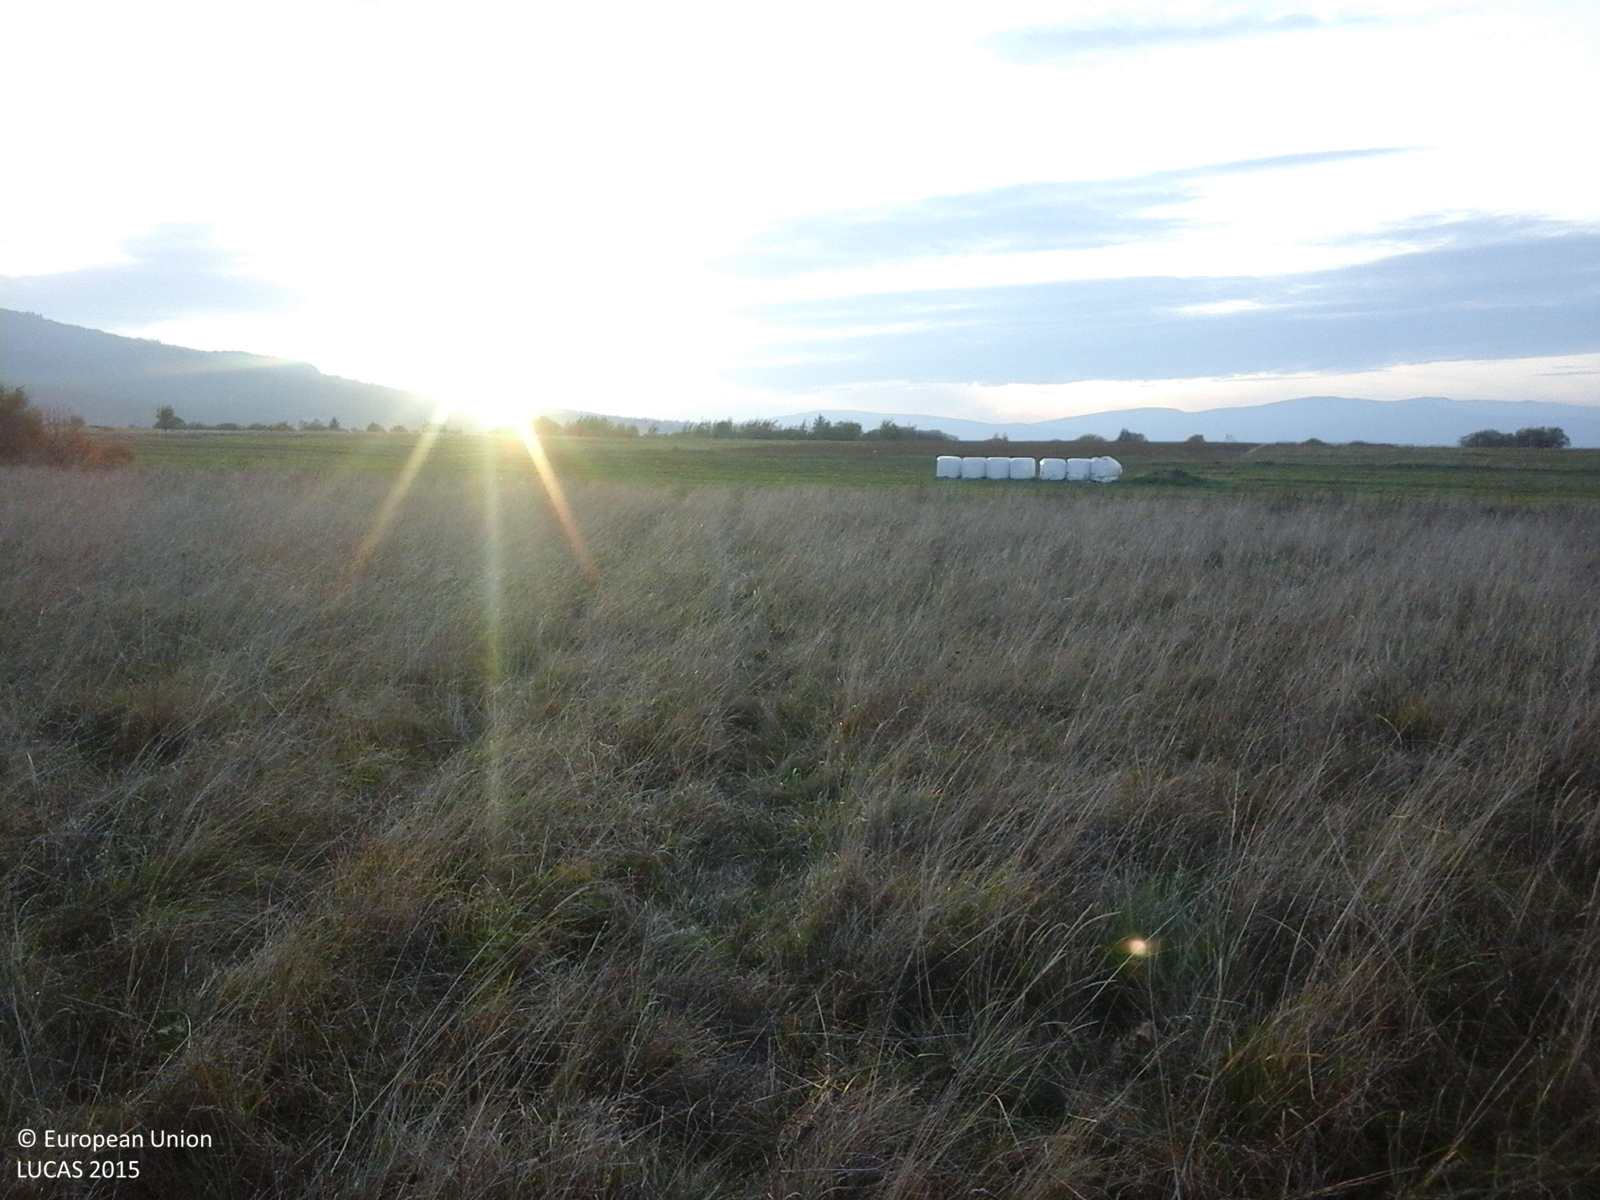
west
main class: Grassland
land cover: Grassland without tree/shrub cover
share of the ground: > 75 %
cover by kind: herbaceous plants 100 %
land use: Agriculture (excluding fallow land and kitchen gardens)
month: October
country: RO
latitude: 46.6541
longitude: 25.5434
